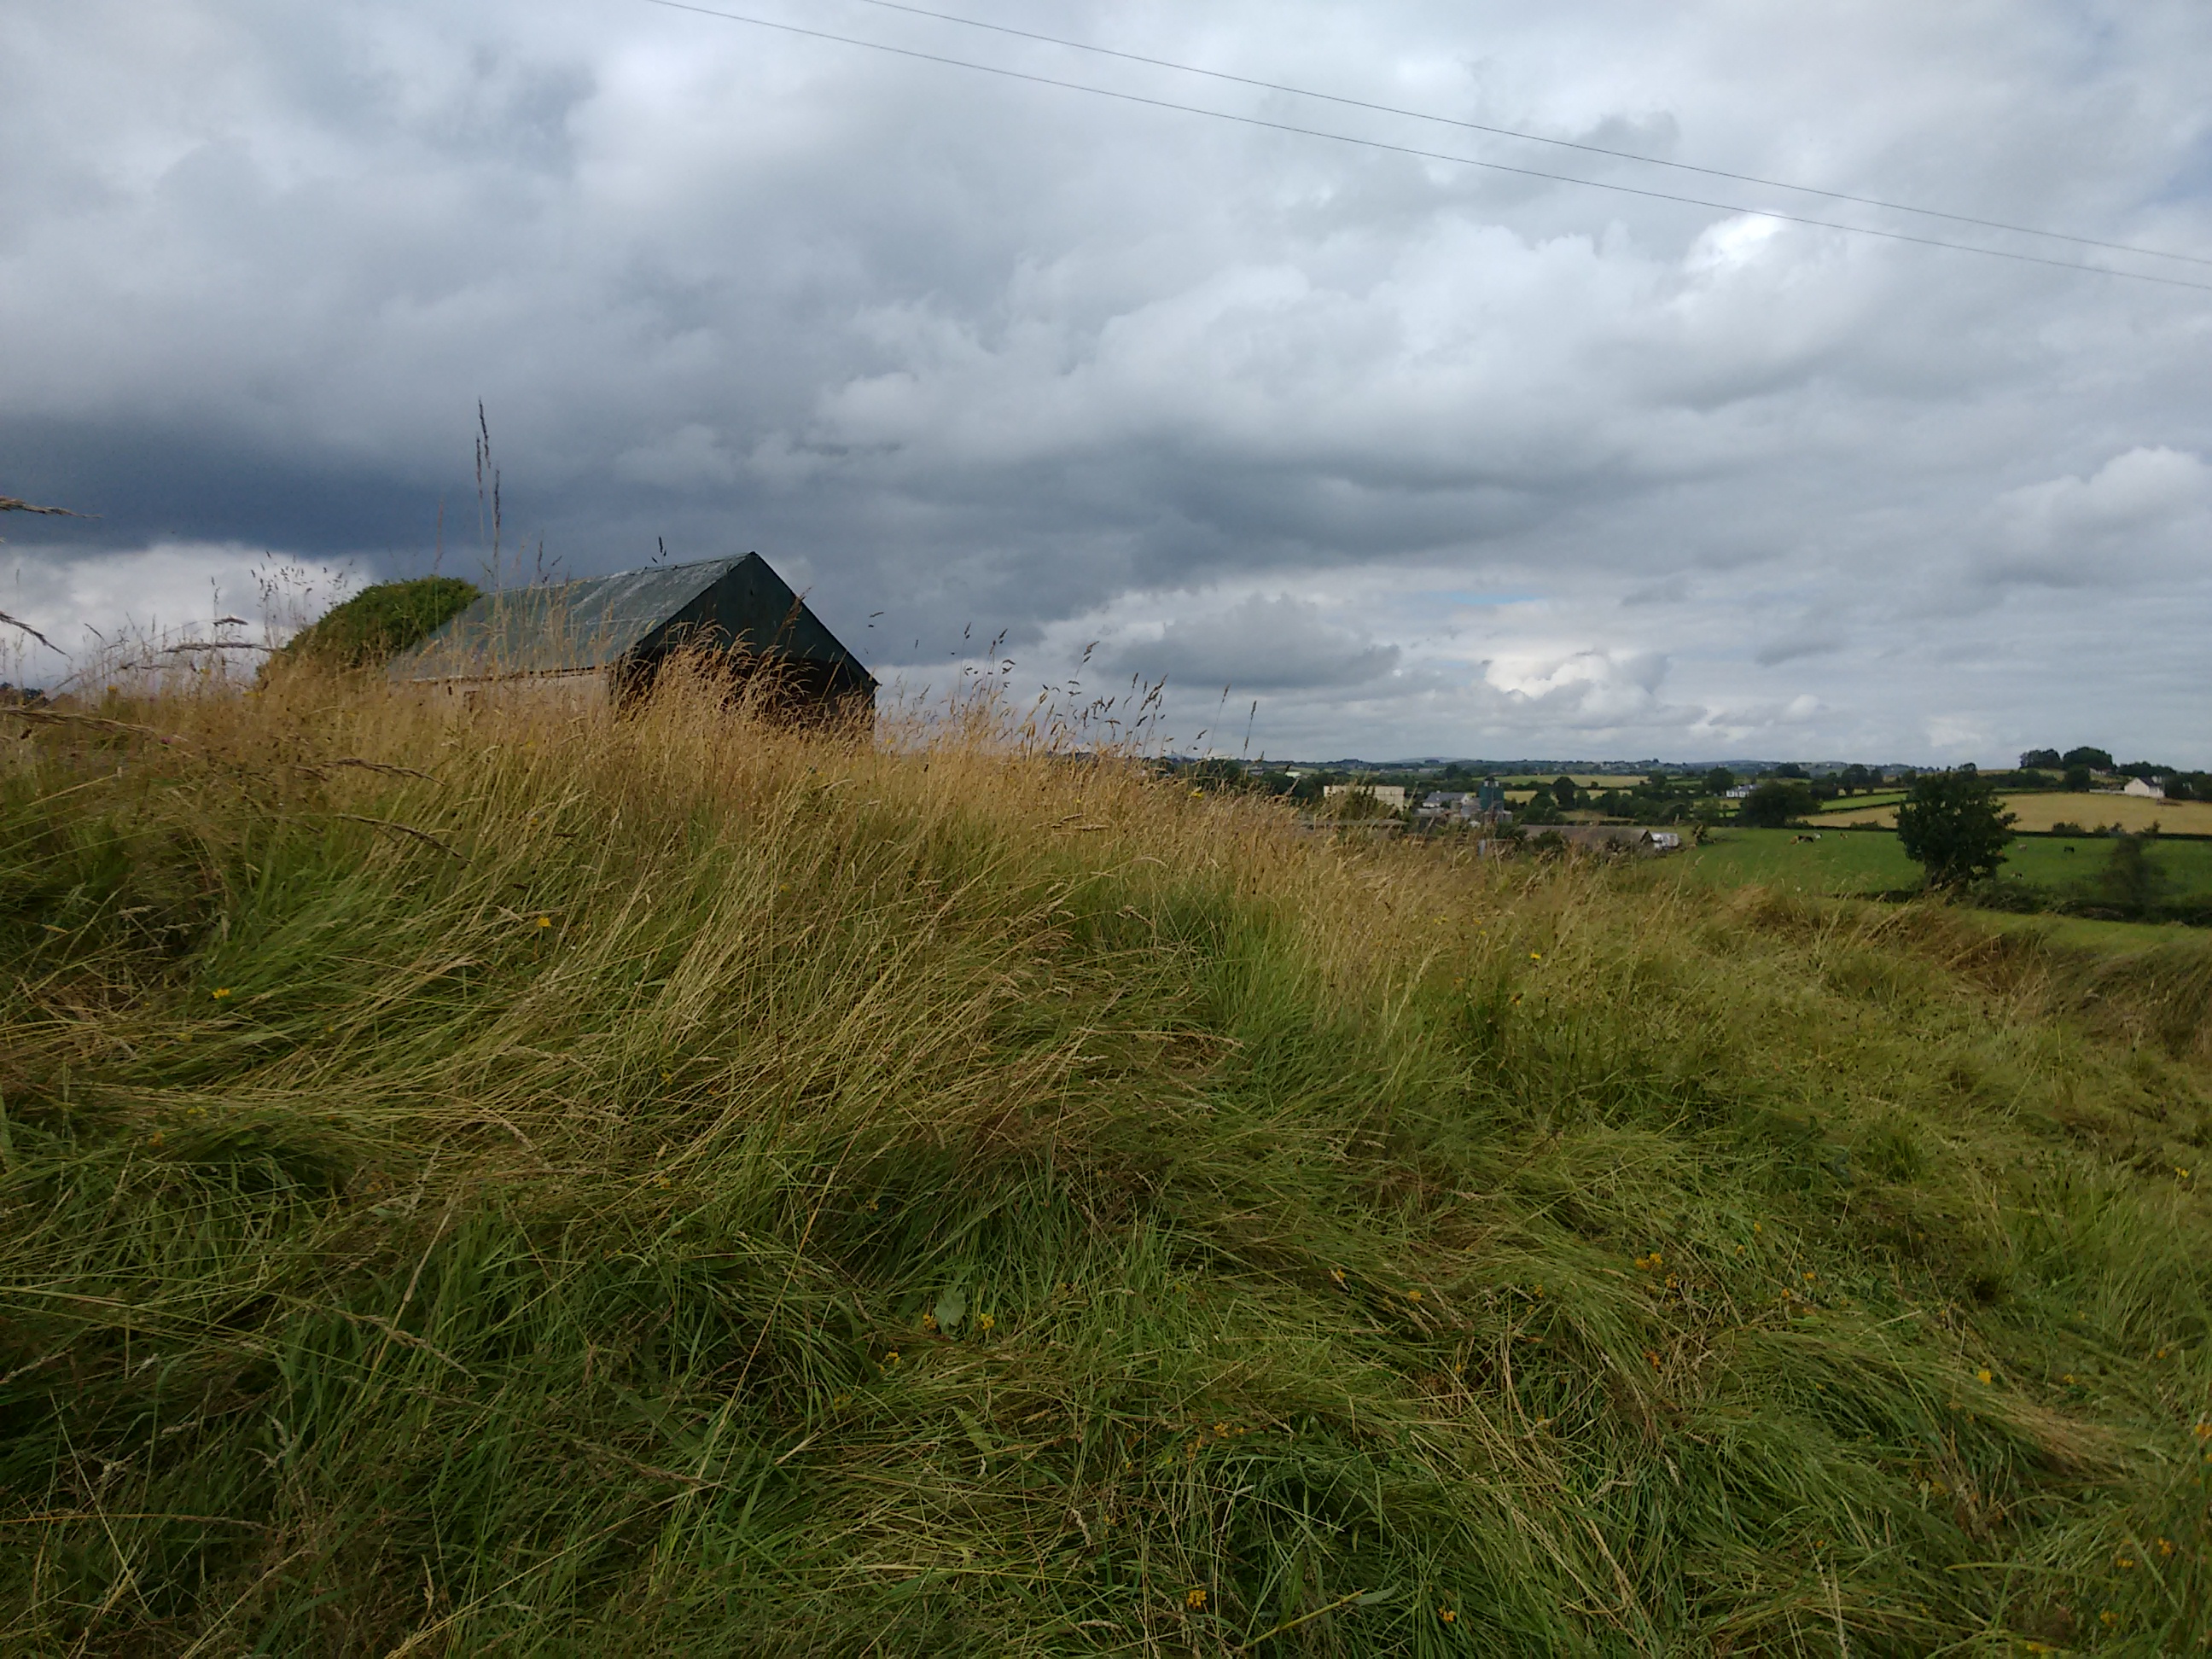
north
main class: Grassland
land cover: Grassland without tree/shrub cover
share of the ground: > 75 %
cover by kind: herbaceous plants 100 %
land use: Agriculture (excluding fallow land and kitchen gardens)
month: August
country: GB
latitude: 54.5593
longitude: -6.8830
